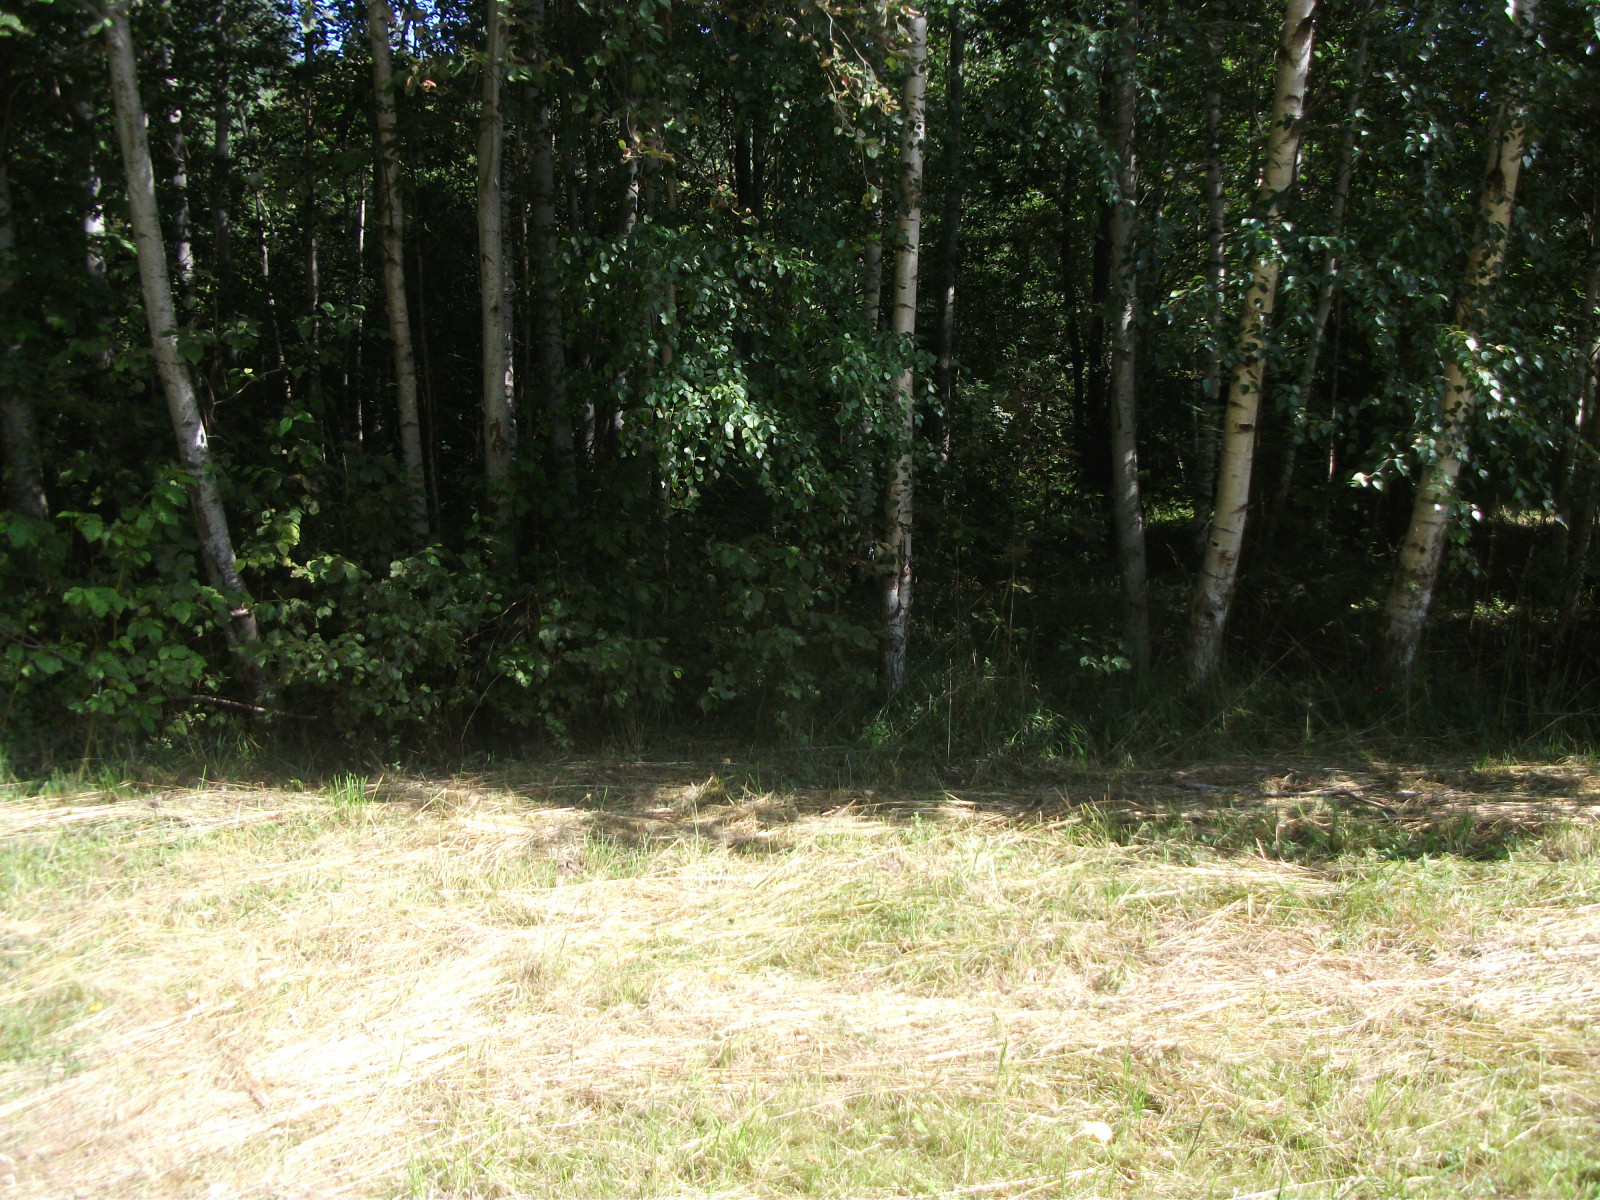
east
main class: Grassland
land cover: Grassland without tree/shrub cover
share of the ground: > 75 %
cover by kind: herbaceous plants 100 %
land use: Agriculture (excluding fallow land and kitchen gardens)
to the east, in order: Grassland without tree/shrub cover; Broadleaved woodland; Grassland without tree/shrub cover; Broadleaved woodland; Grassland with sparse tree/shrub cover; Artificial constructions; Broadleaved woodland
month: August
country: LV
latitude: 57.0930
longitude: 26.6703
